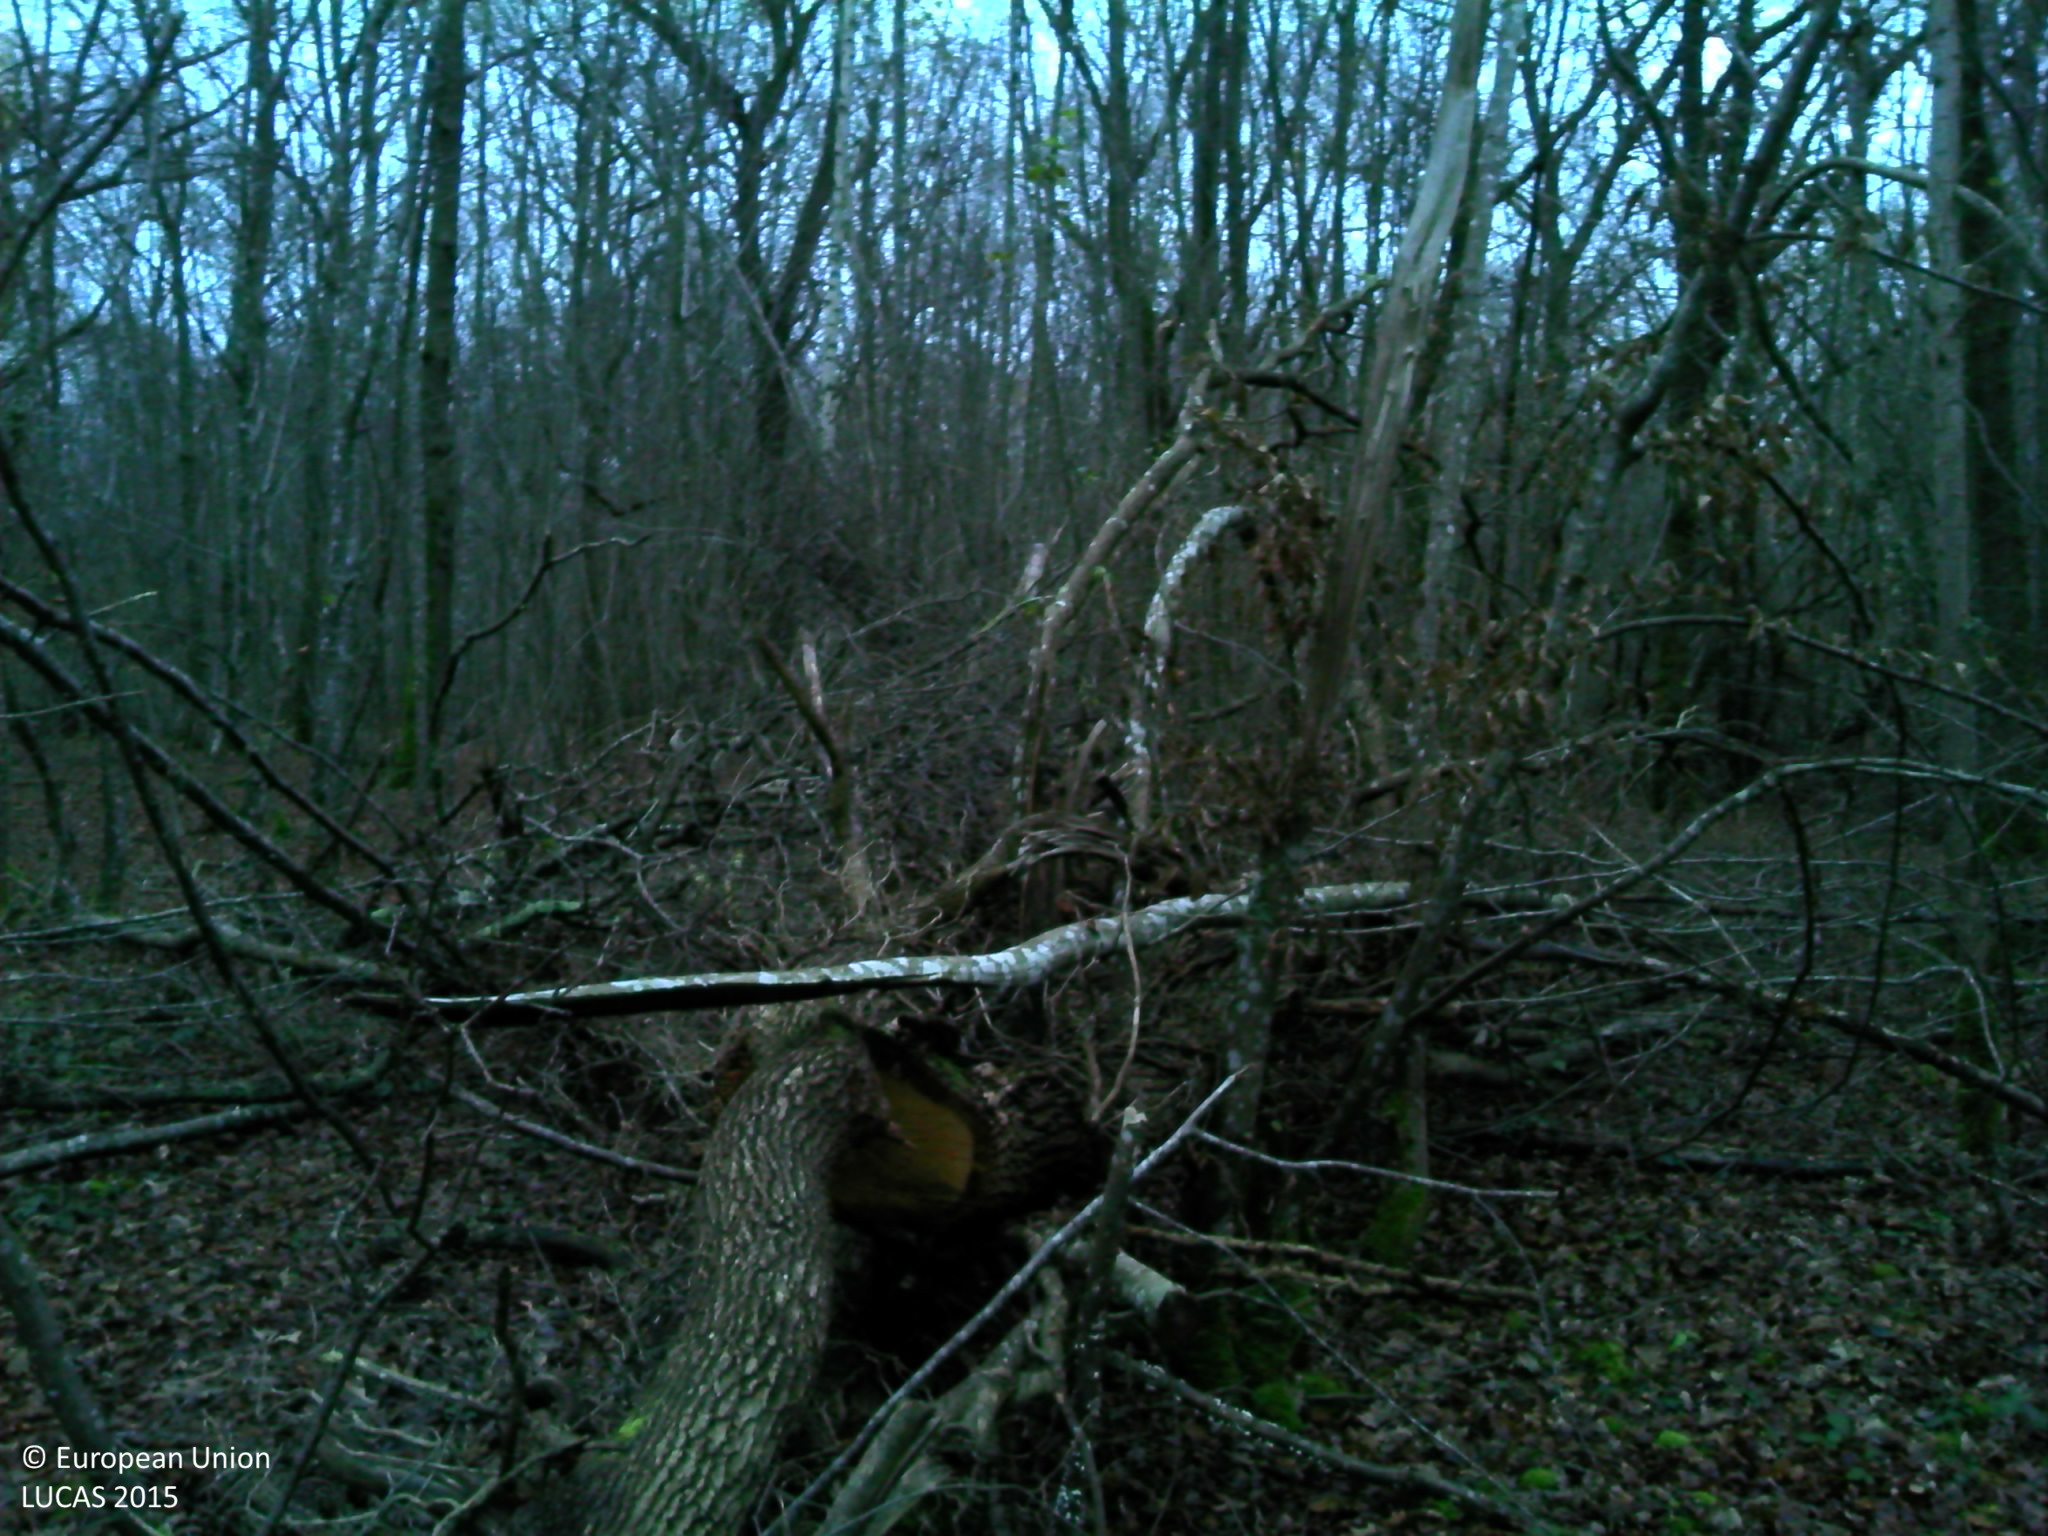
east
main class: Woodland
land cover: Broadleaved woodland
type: acidophilous oak and oak-birch forest
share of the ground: > 75 %
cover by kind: broadleaved forest trees 95 %, shrubs 5 %
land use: Forestry
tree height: > 5 m
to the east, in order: Broadleaved woodland; Ditches and canals; Broadleaved woodland; Tracks; Broadleaved woodland
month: December
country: FR
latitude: 46.5880
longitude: 3.2241
